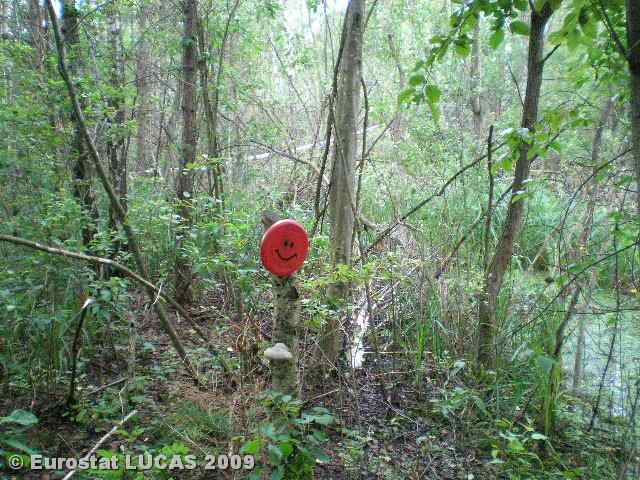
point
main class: Woodland
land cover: Mixed woodland
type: hemiboreal forest and nemoral coniferous forest and mixed broadleaved-coniferous forest
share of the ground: > 75 %
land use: Forestry
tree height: > 5 m
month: July
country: LT
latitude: 54.7373
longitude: 25.3915
